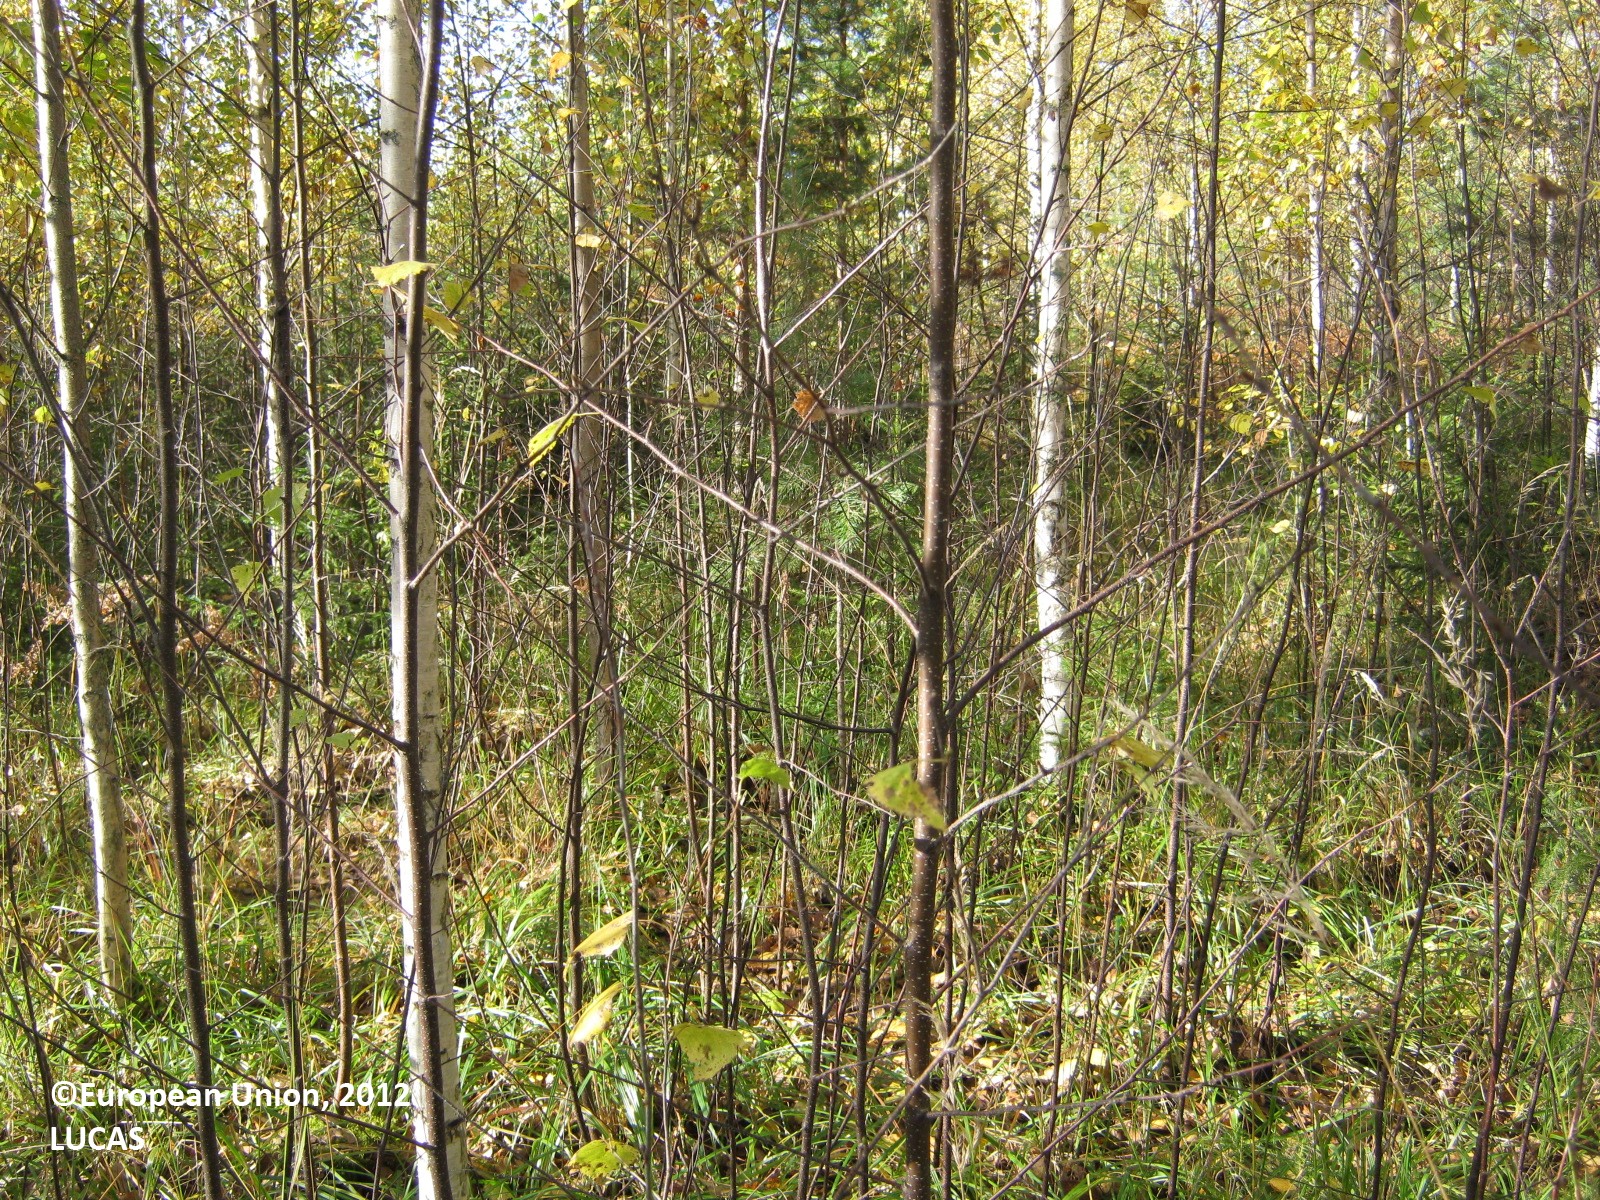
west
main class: Woodland
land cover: Broadleaved woodland
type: boreal forest
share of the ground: > 75 %
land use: Forestry
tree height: > 5 m
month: September
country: FI
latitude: 62.3973
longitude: 28.8052
